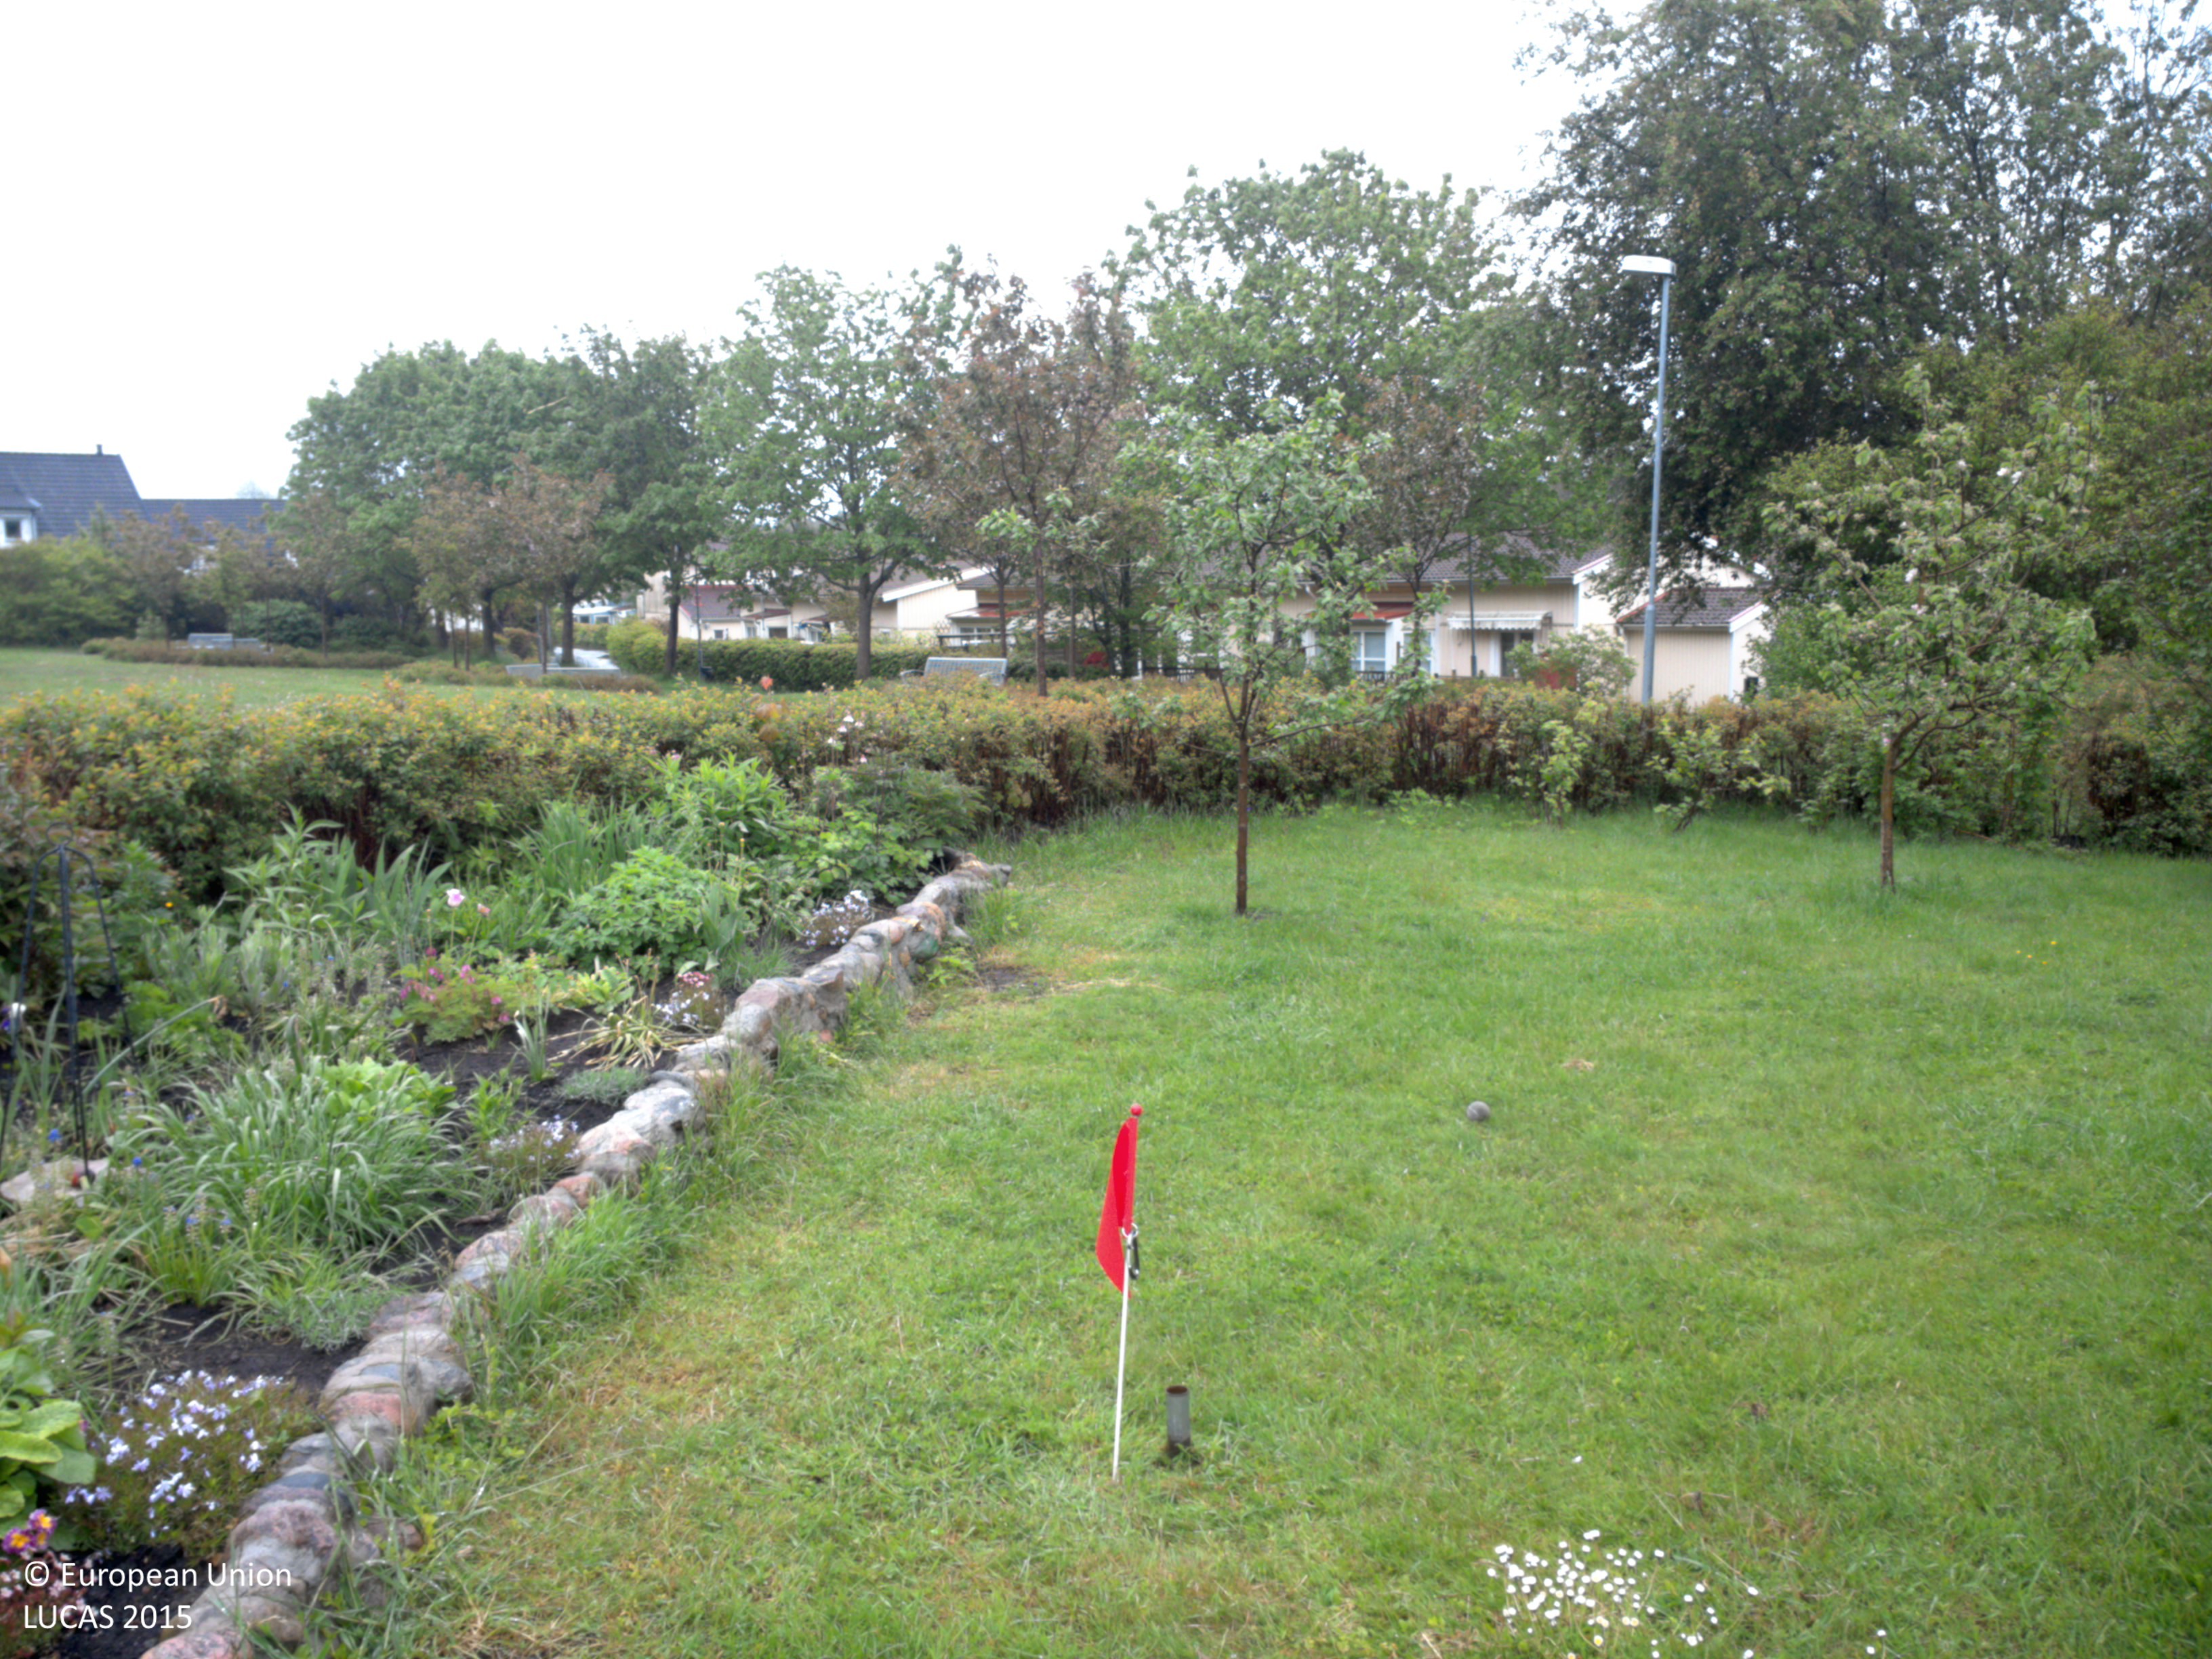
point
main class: Grassland
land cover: Grassland without tree/shrub cover
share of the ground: > 75 %
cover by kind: herbaceous plants 100 %
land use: Residential
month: June
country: SE
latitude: 57.8399
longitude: 12.3038
